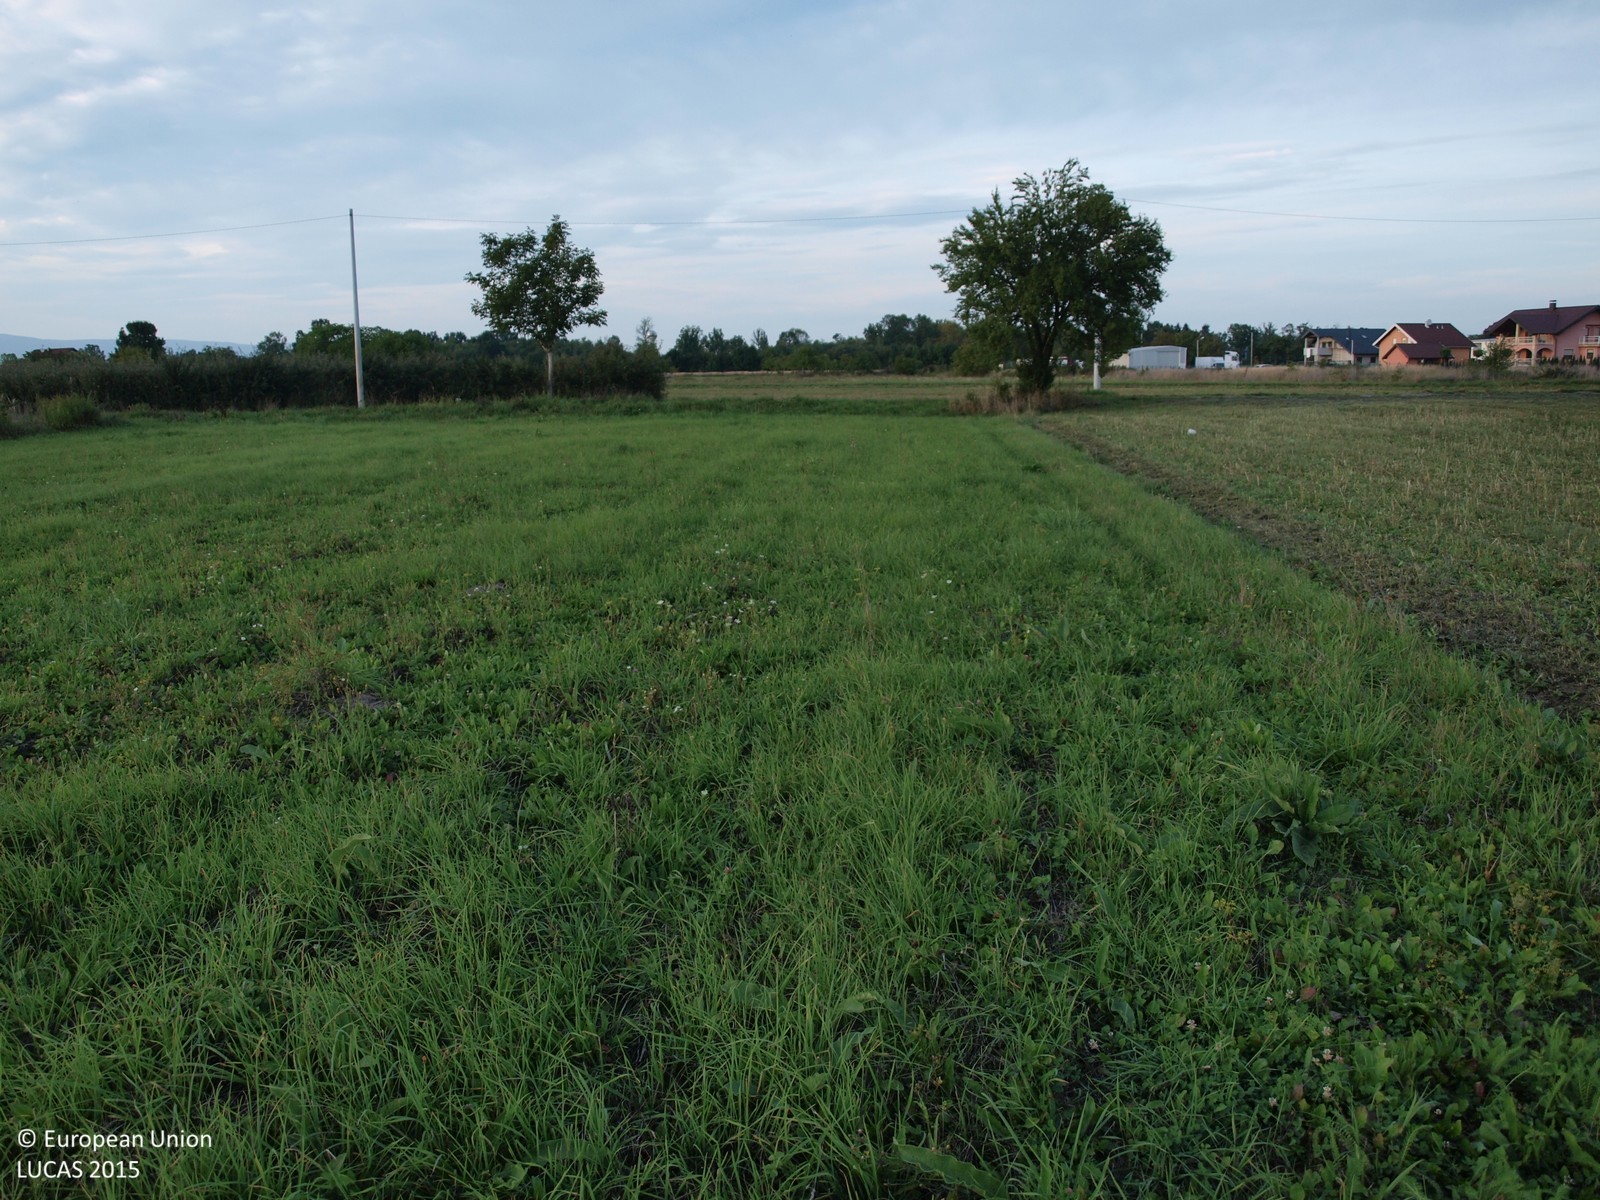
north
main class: Grassland
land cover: Grassland without tree/shrub cover
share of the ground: > 75 %
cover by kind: herbaceous plants 100 %
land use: Agriculture (excluding fallow land and kitchen gardens)
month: September
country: HR
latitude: 45.7269
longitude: 16.0756
